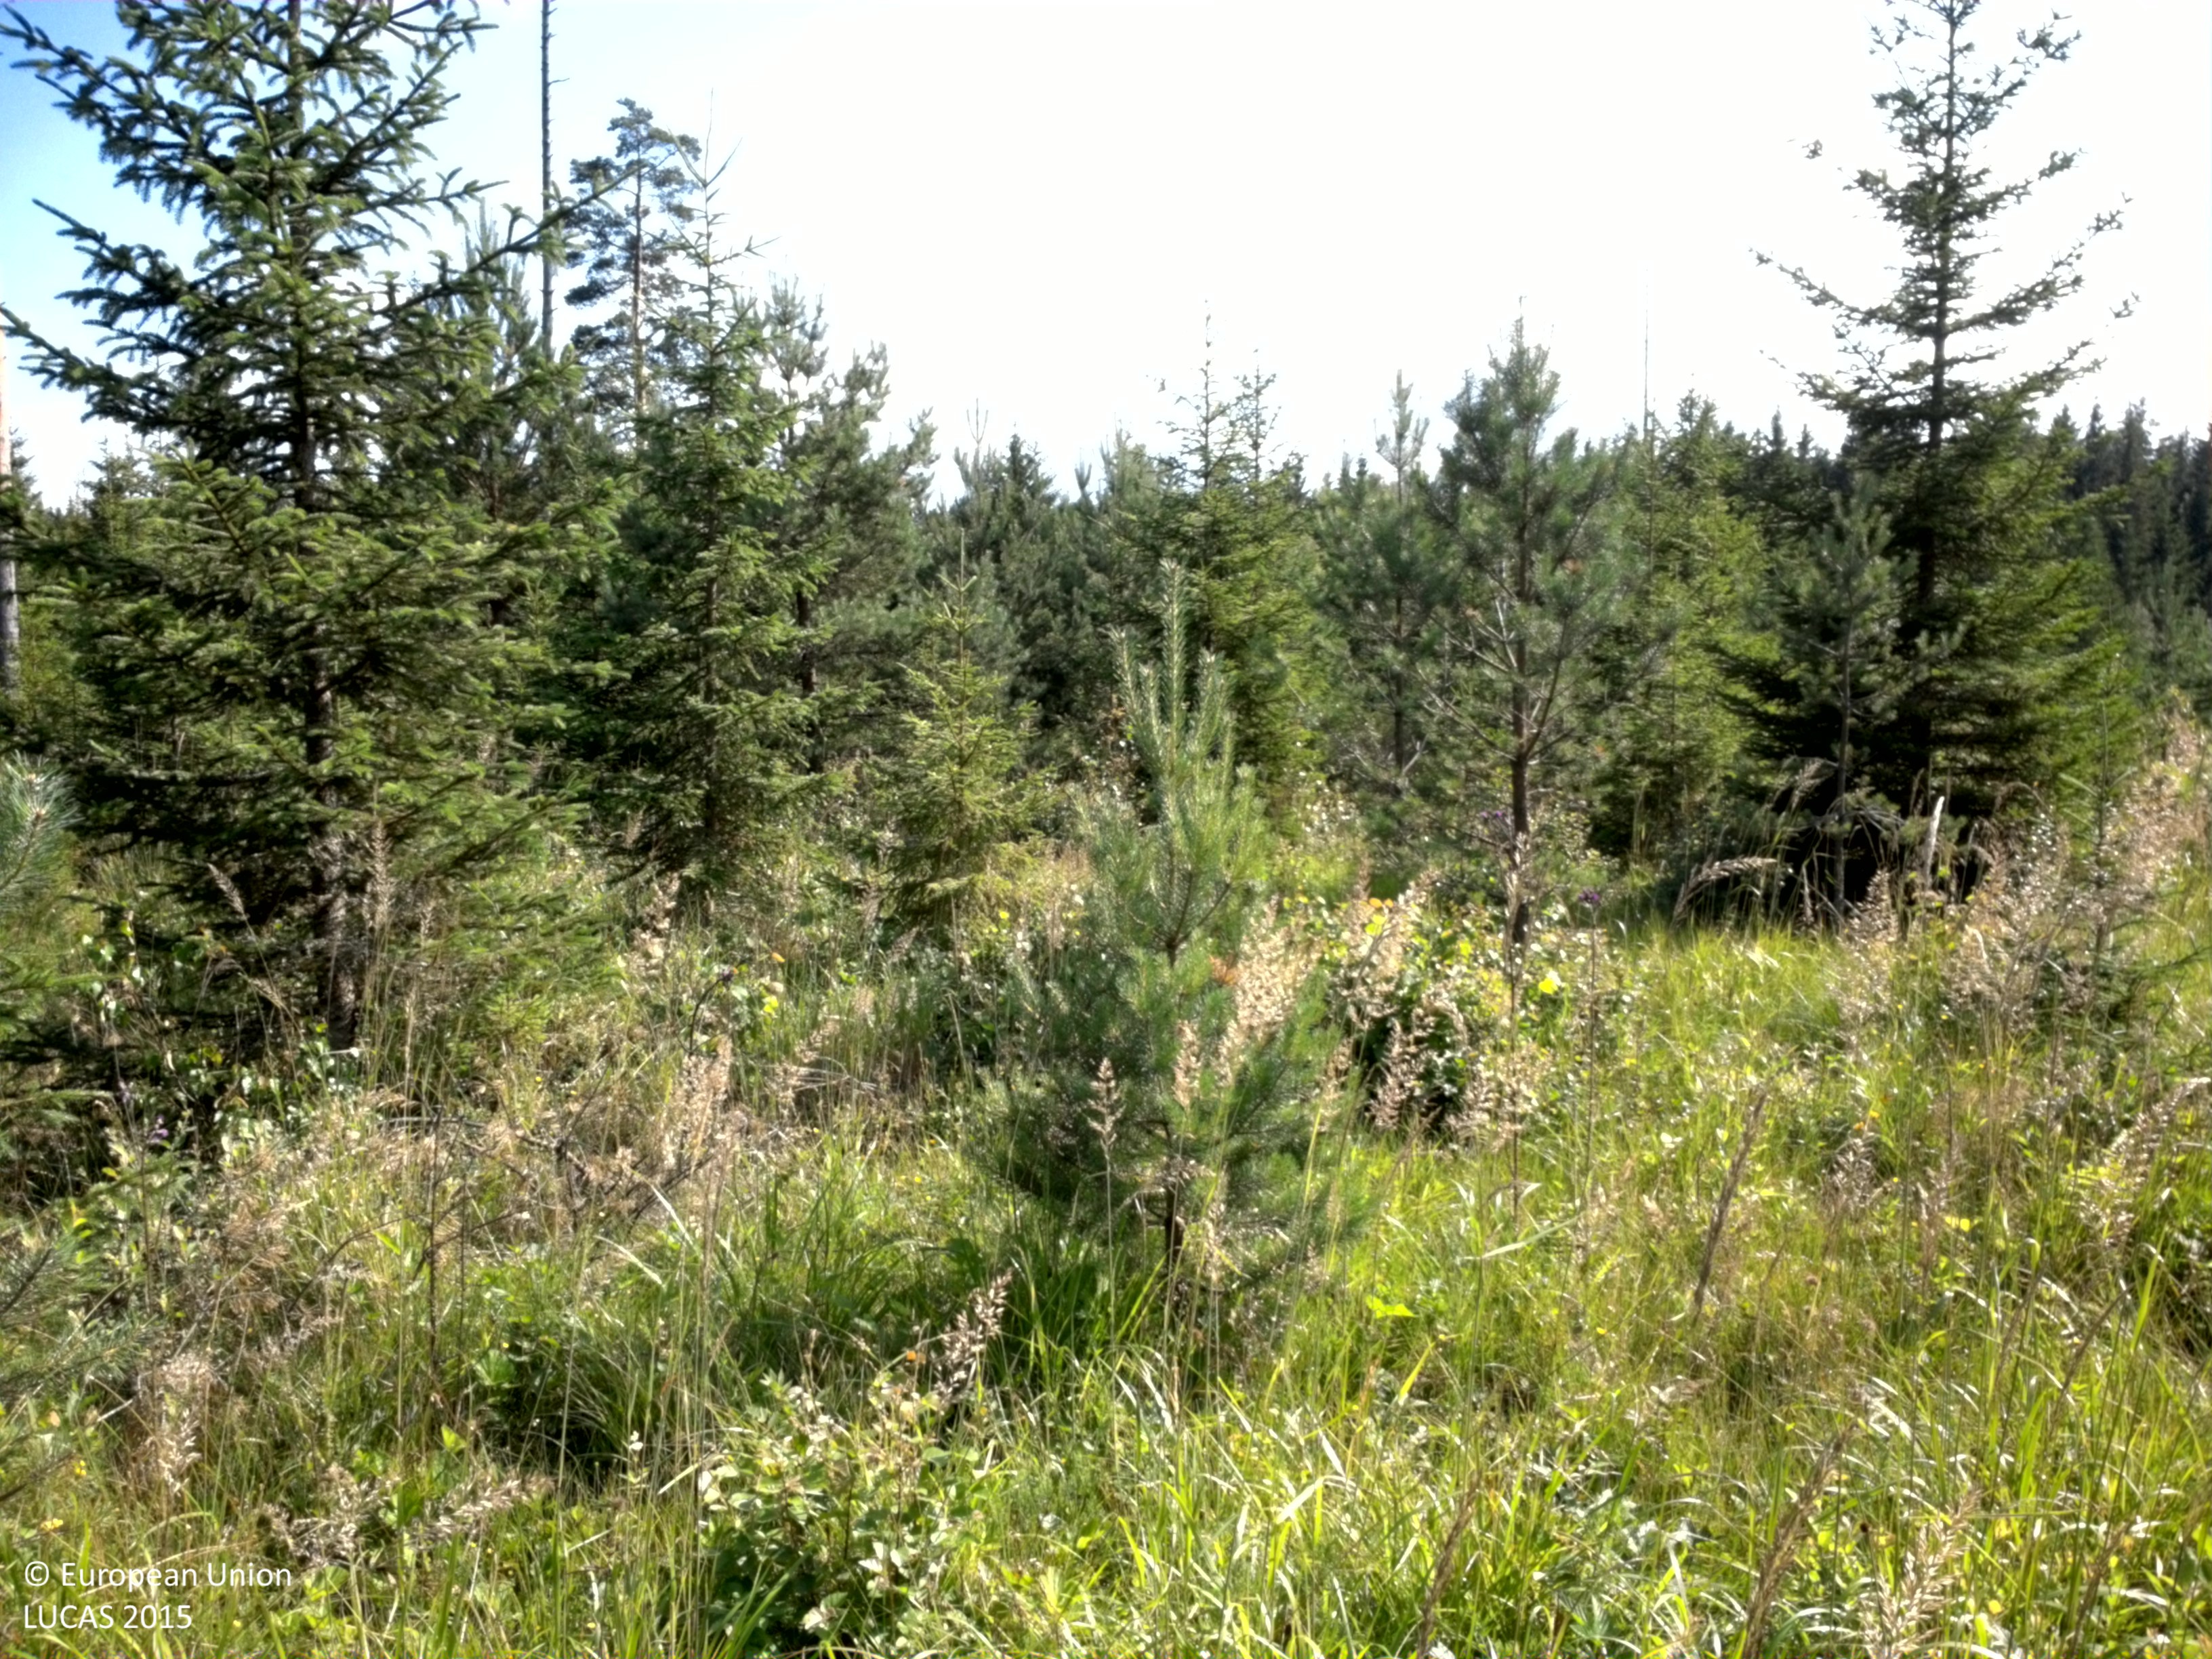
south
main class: Woodland
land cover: Spruce dominated coniferous woodland
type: boreal forest
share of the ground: 25 - 50 %
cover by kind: coniferous forest trees 50 %, herbaceous plants 50 %
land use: Forestry
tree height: < 5 m
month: July
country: SE
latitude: 59.6522
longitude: 18.4989
